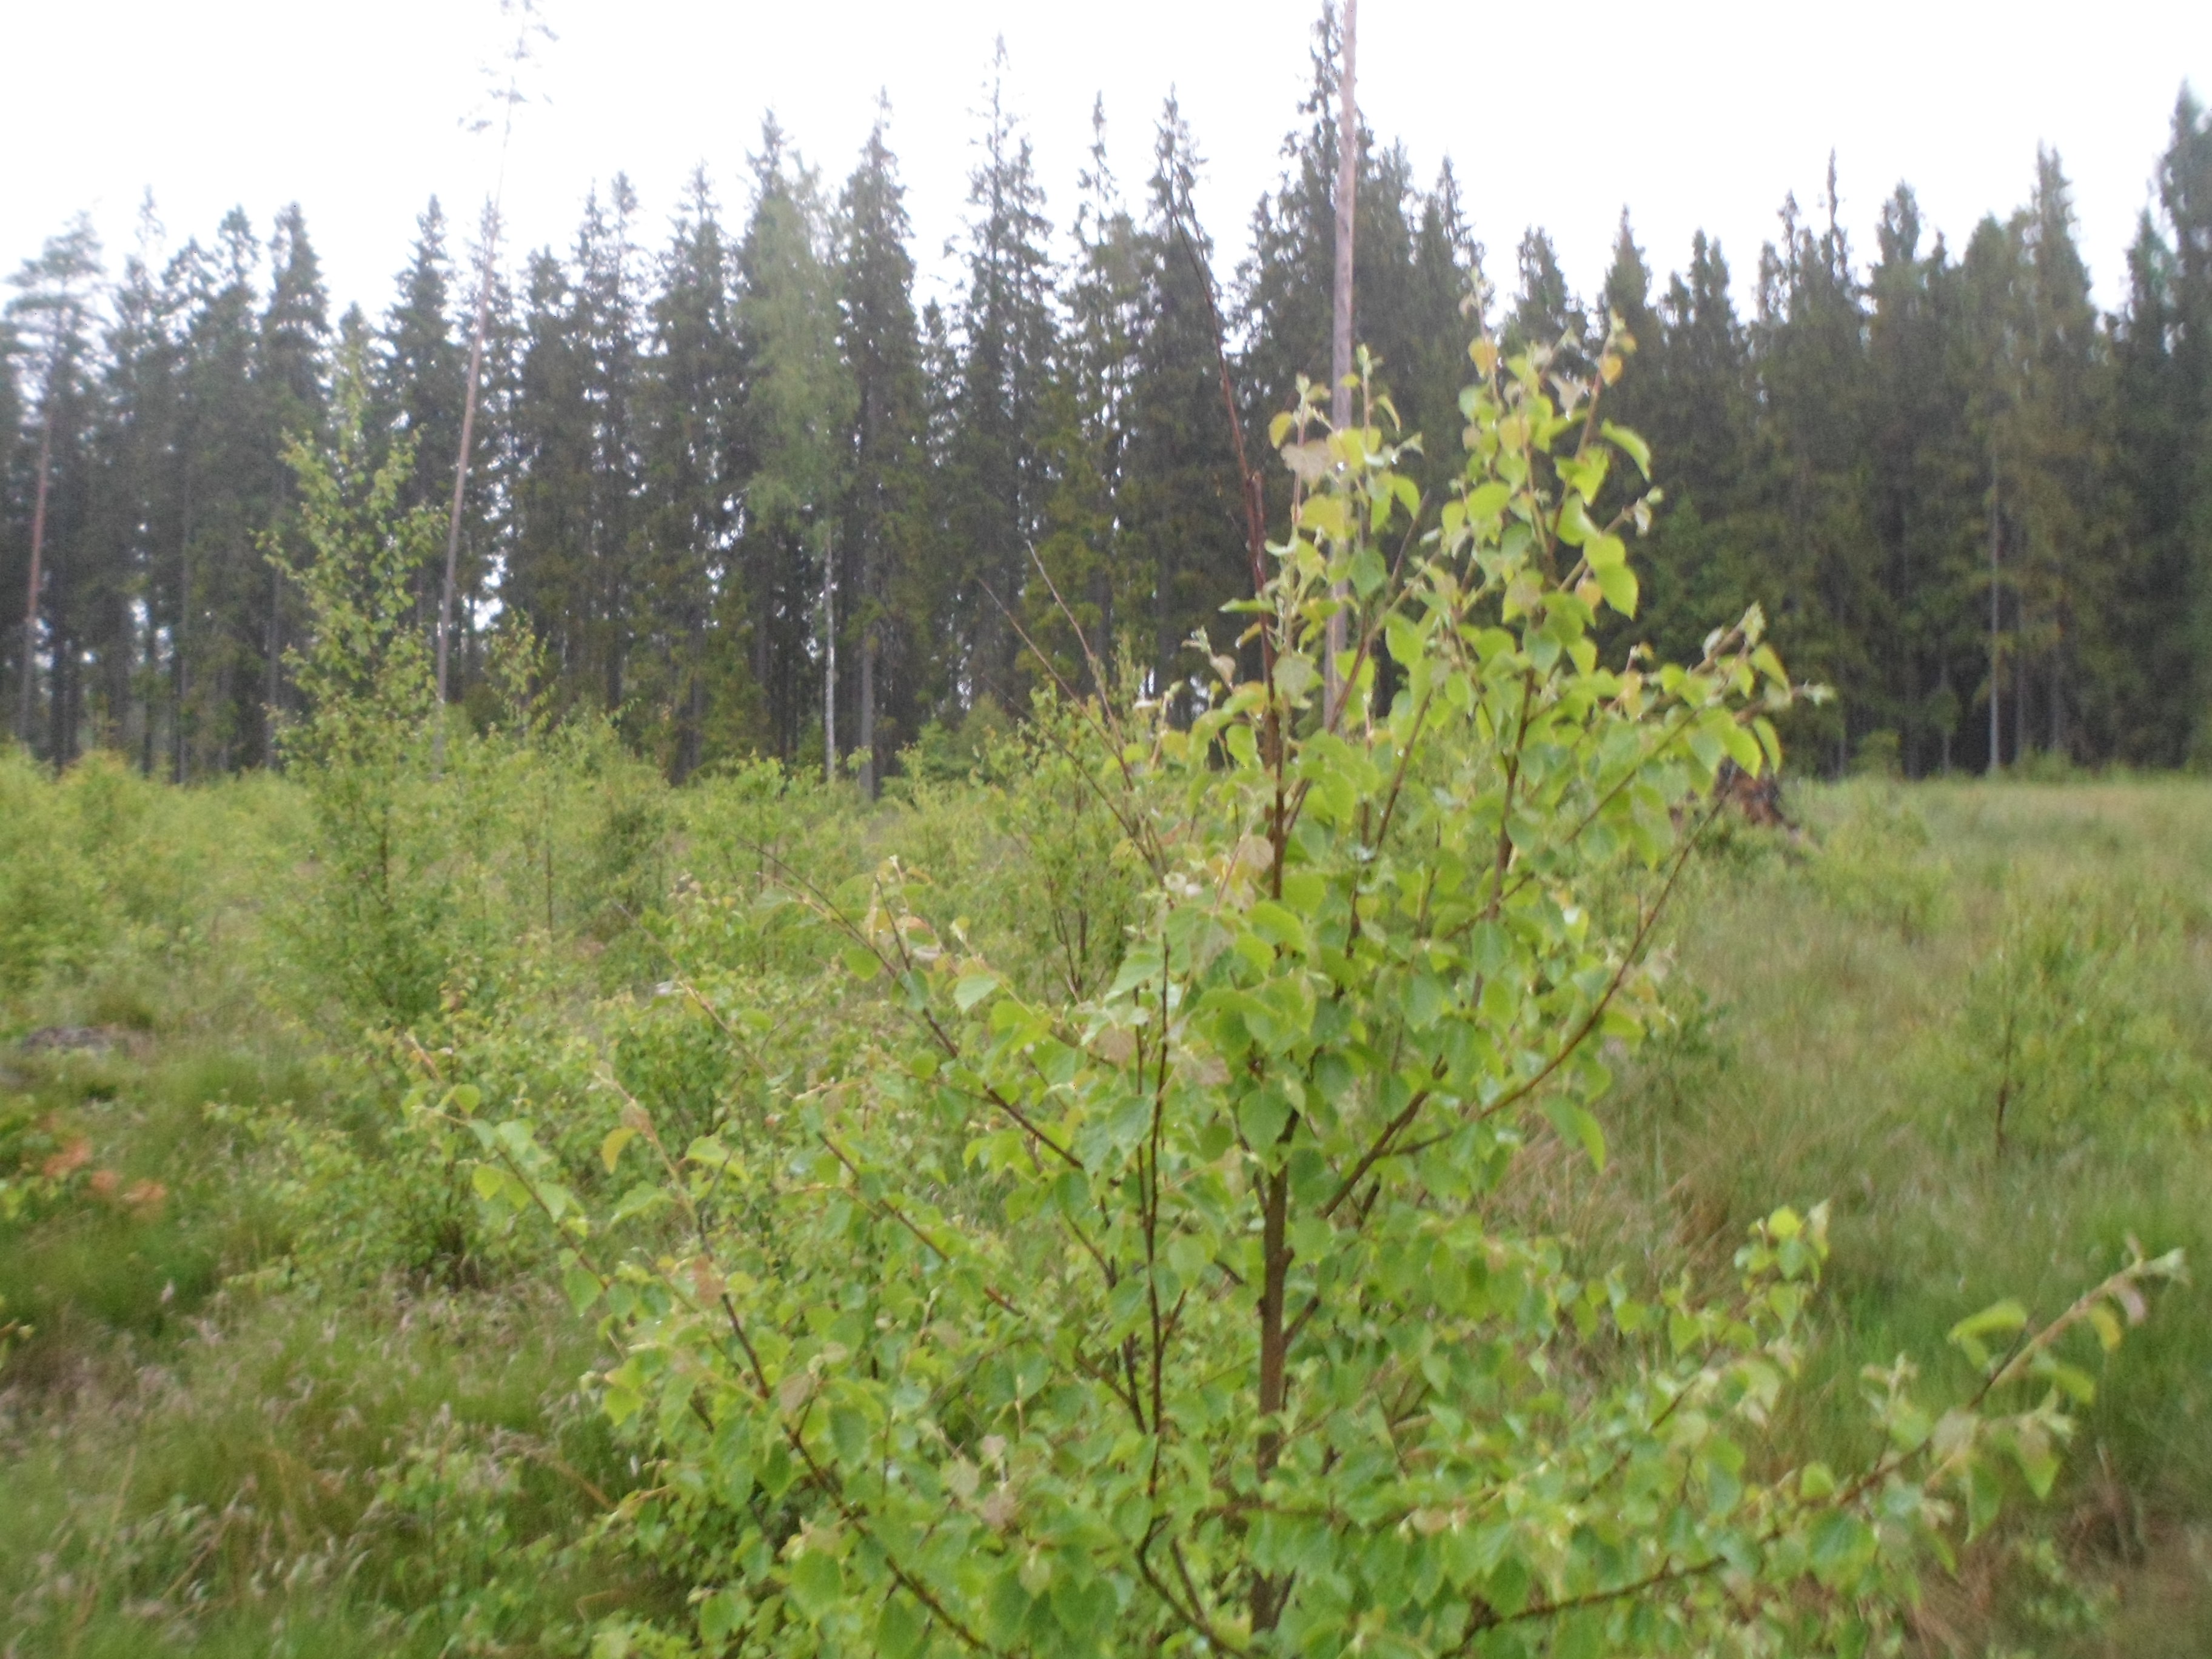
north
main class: Woodland
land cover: Broadleaved woodland
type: boreal forest
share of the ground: 50 - 75 %
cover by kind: broadleaved forest trees 65 %, herbaceous plants 20 %, shrubs 10 %, coniferous forest trees 5 %
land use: Forestry
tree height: > 5 m
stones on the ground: < 10 %
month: June
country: SE
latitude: 57.6316
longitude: 14.1989
